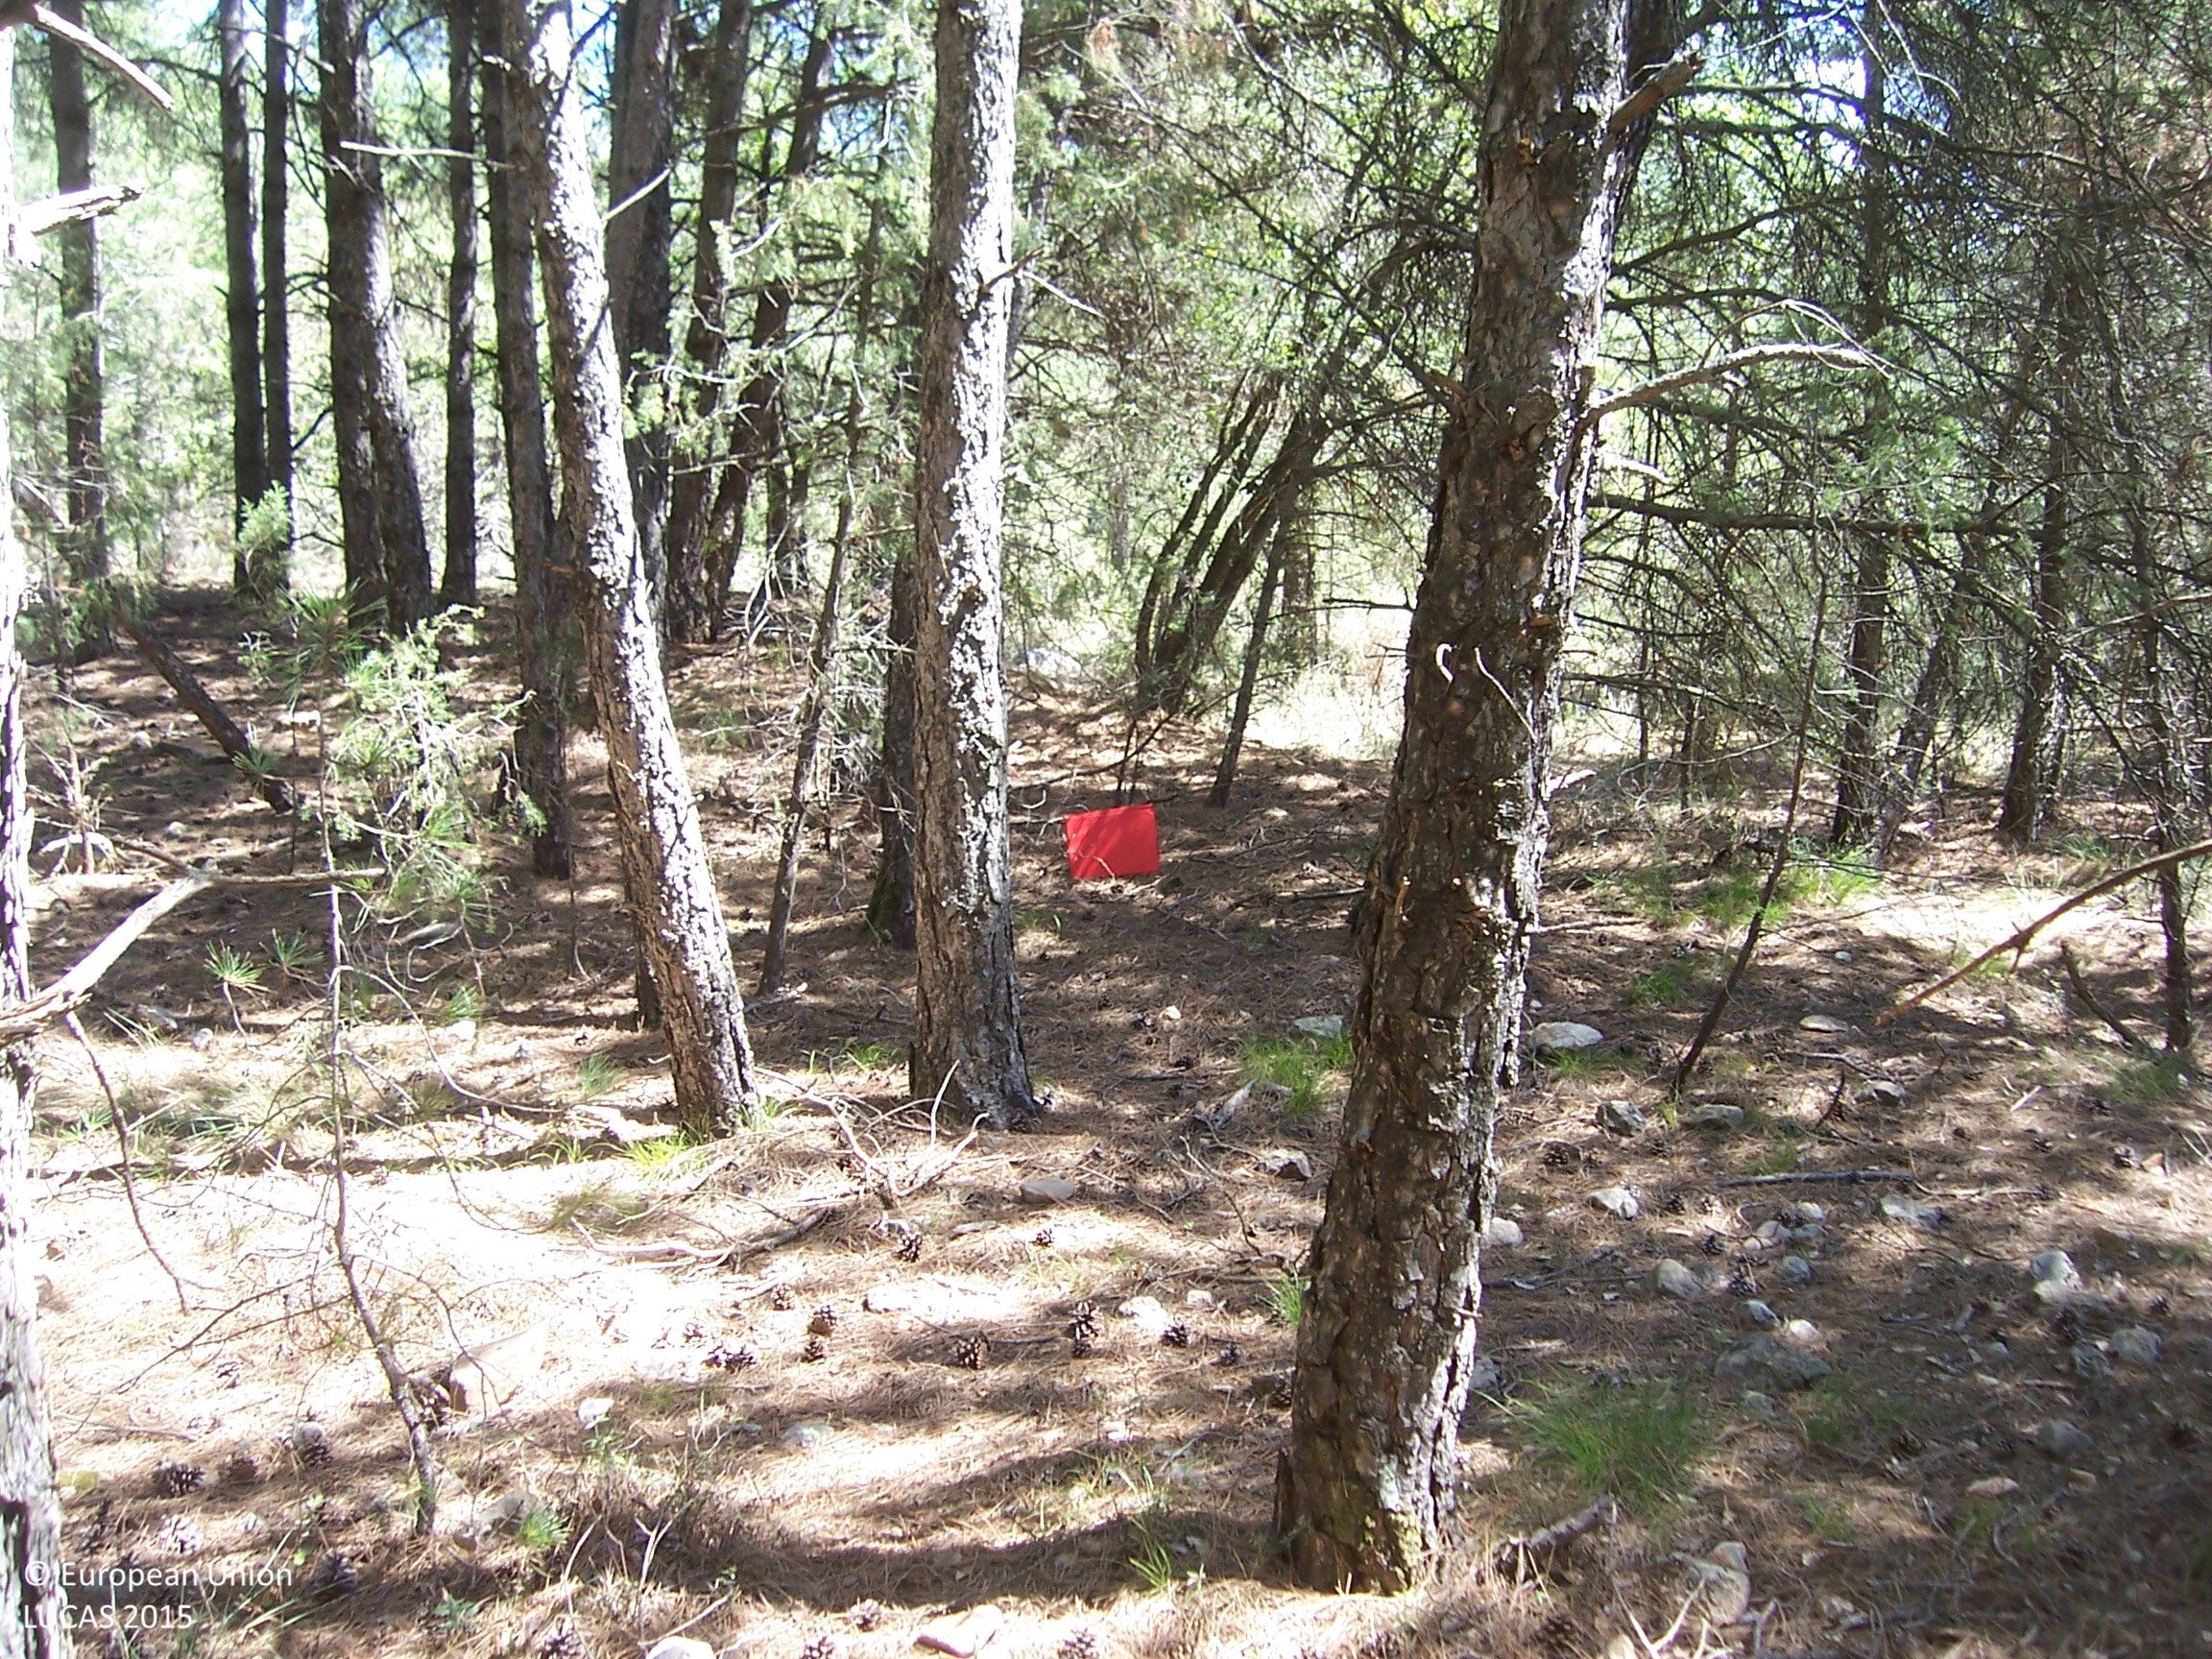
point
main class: Woodland
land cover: Pine dominated coniferous woodland
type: coniferous forest of the mediterranean region
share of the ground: > 75 %
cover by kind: coniferous forest trees 100 %
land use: Forestry
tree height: > 5 m
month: August
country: ES
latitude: 42.3087
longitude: 0.2386
